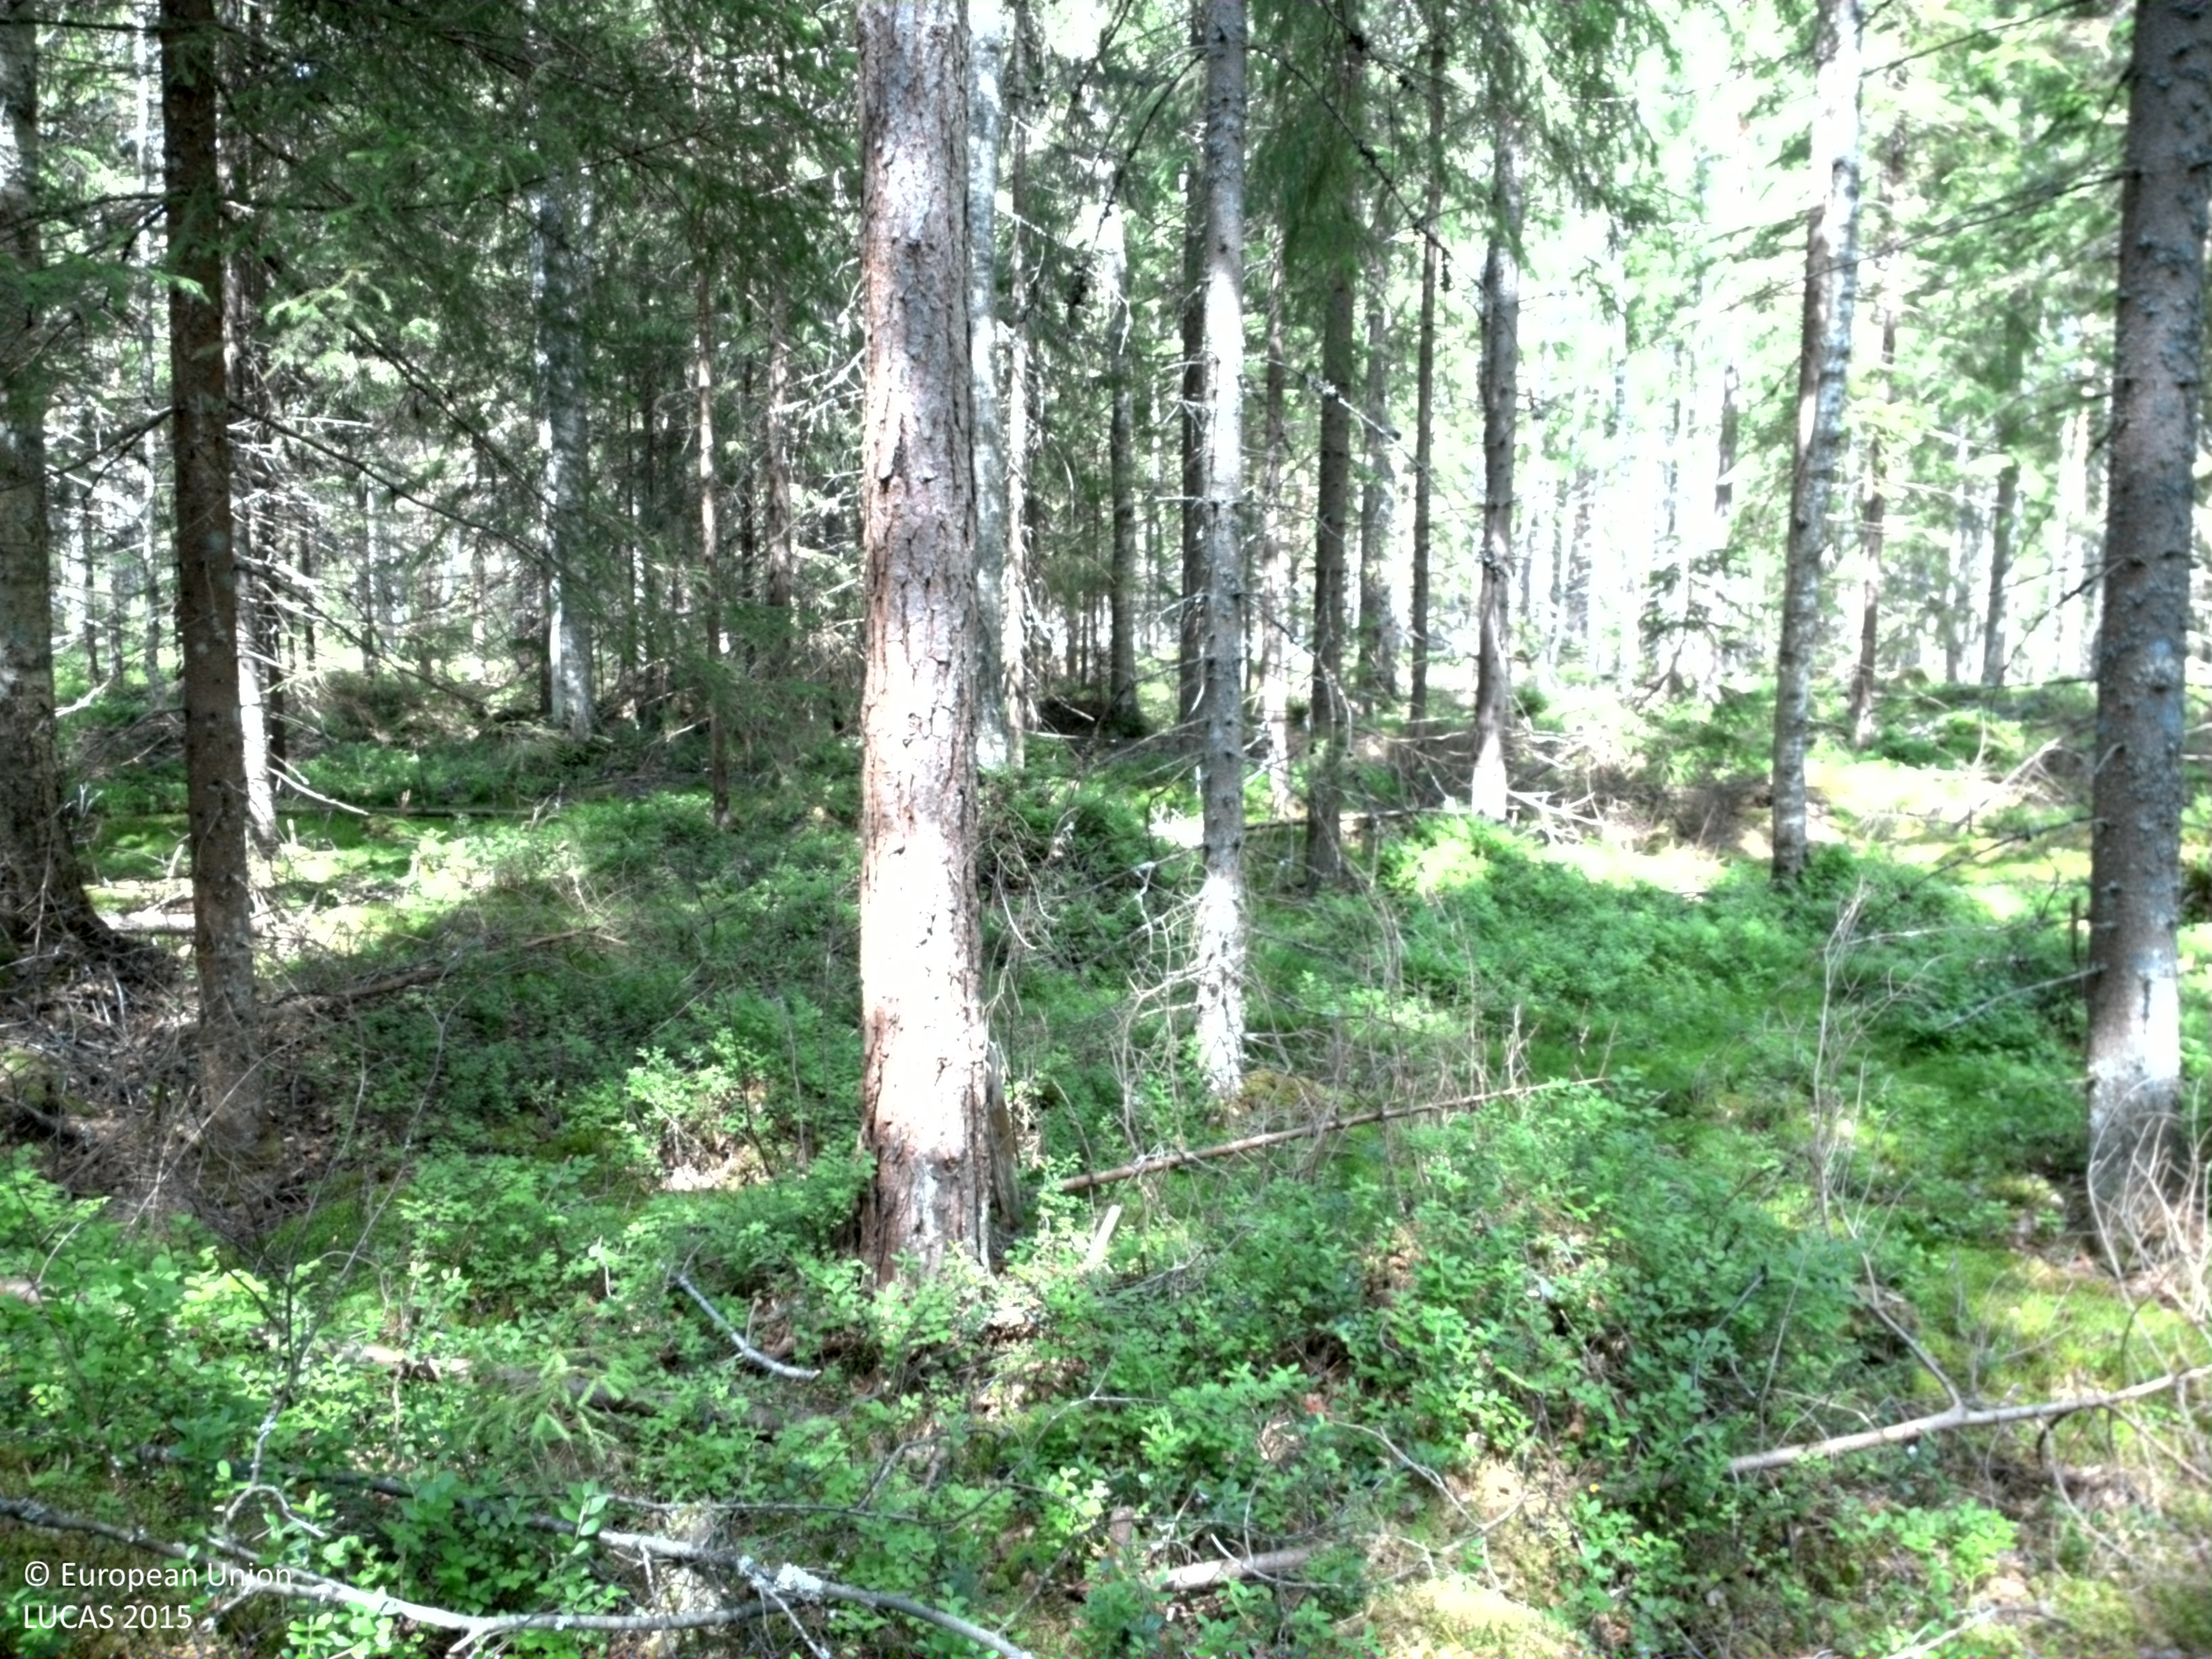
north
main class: Woodland
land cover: Spruce dominated mixed woodland
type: boreal forest
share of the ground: 25 - 50 %
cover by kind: herbaceous plants 35 %, coniferous forest trees 30 %, lichens and mosses 20 %, broadleaved forest trees 15 %
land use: Forestry
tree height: > 5 m
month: July
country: SE
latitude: 58.8465
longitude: 14.5159
